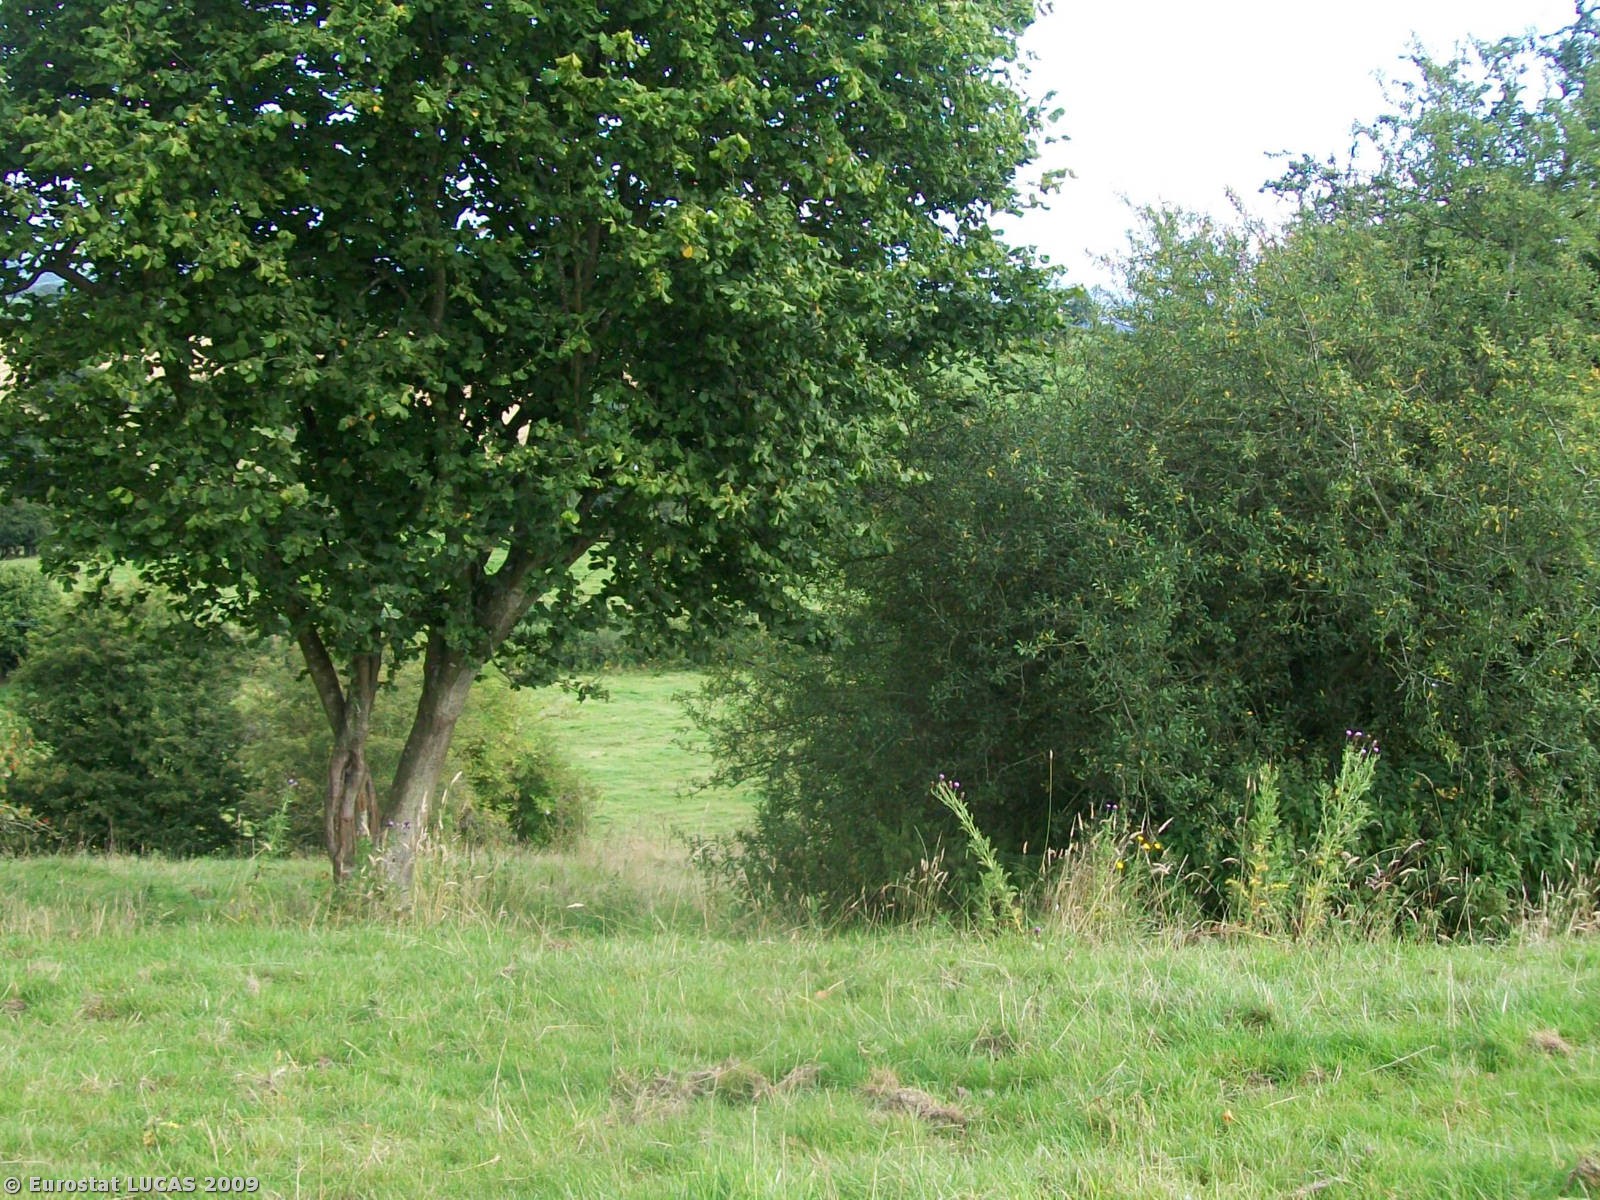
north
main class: Grassland
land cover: Grassland without tree/shrub cover
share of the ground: > 75 %
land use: Agriculture (excluding fallow land and kitchen gardens)
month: August
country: GB
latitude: 52.6448
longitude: -3.3082
